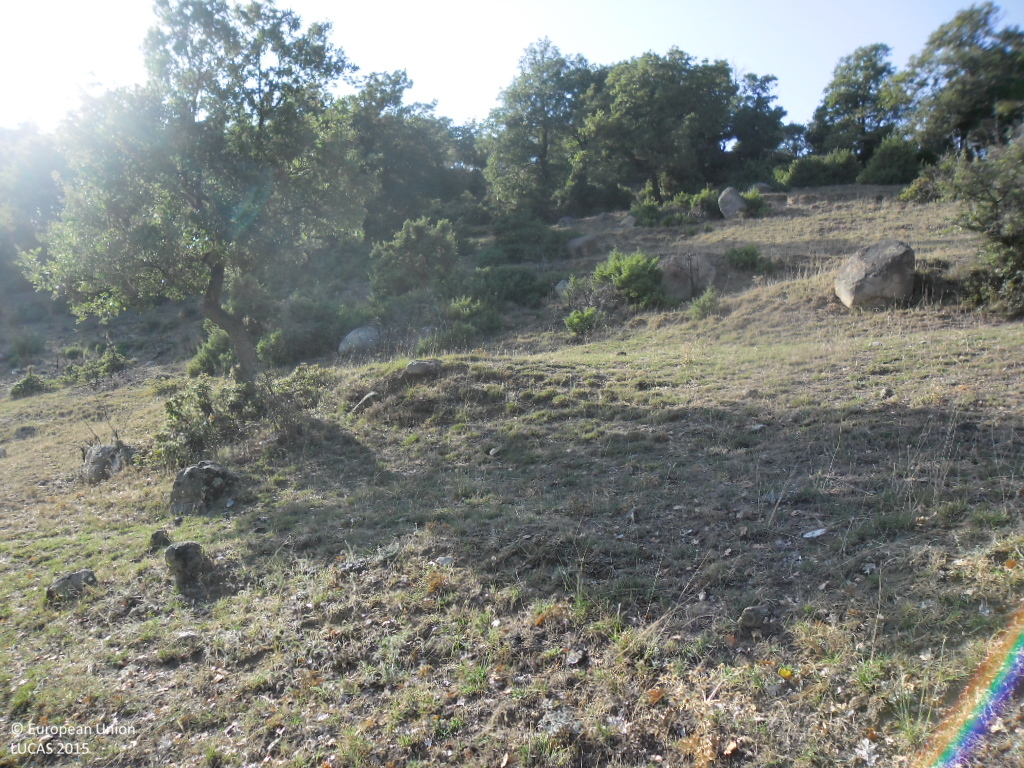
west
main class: Grassland
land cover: Grassland with sparse tree/shrub cover
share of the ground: > 75 %
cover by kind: herbaceous plants 90 %, broadleaved forest trees 5 %, shrubs 5 %
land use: Agriculture (excluding fallow land and kitchen gardens)
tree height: < 5 m
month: September
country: BG
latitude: 41.6250
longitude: 23.3098
